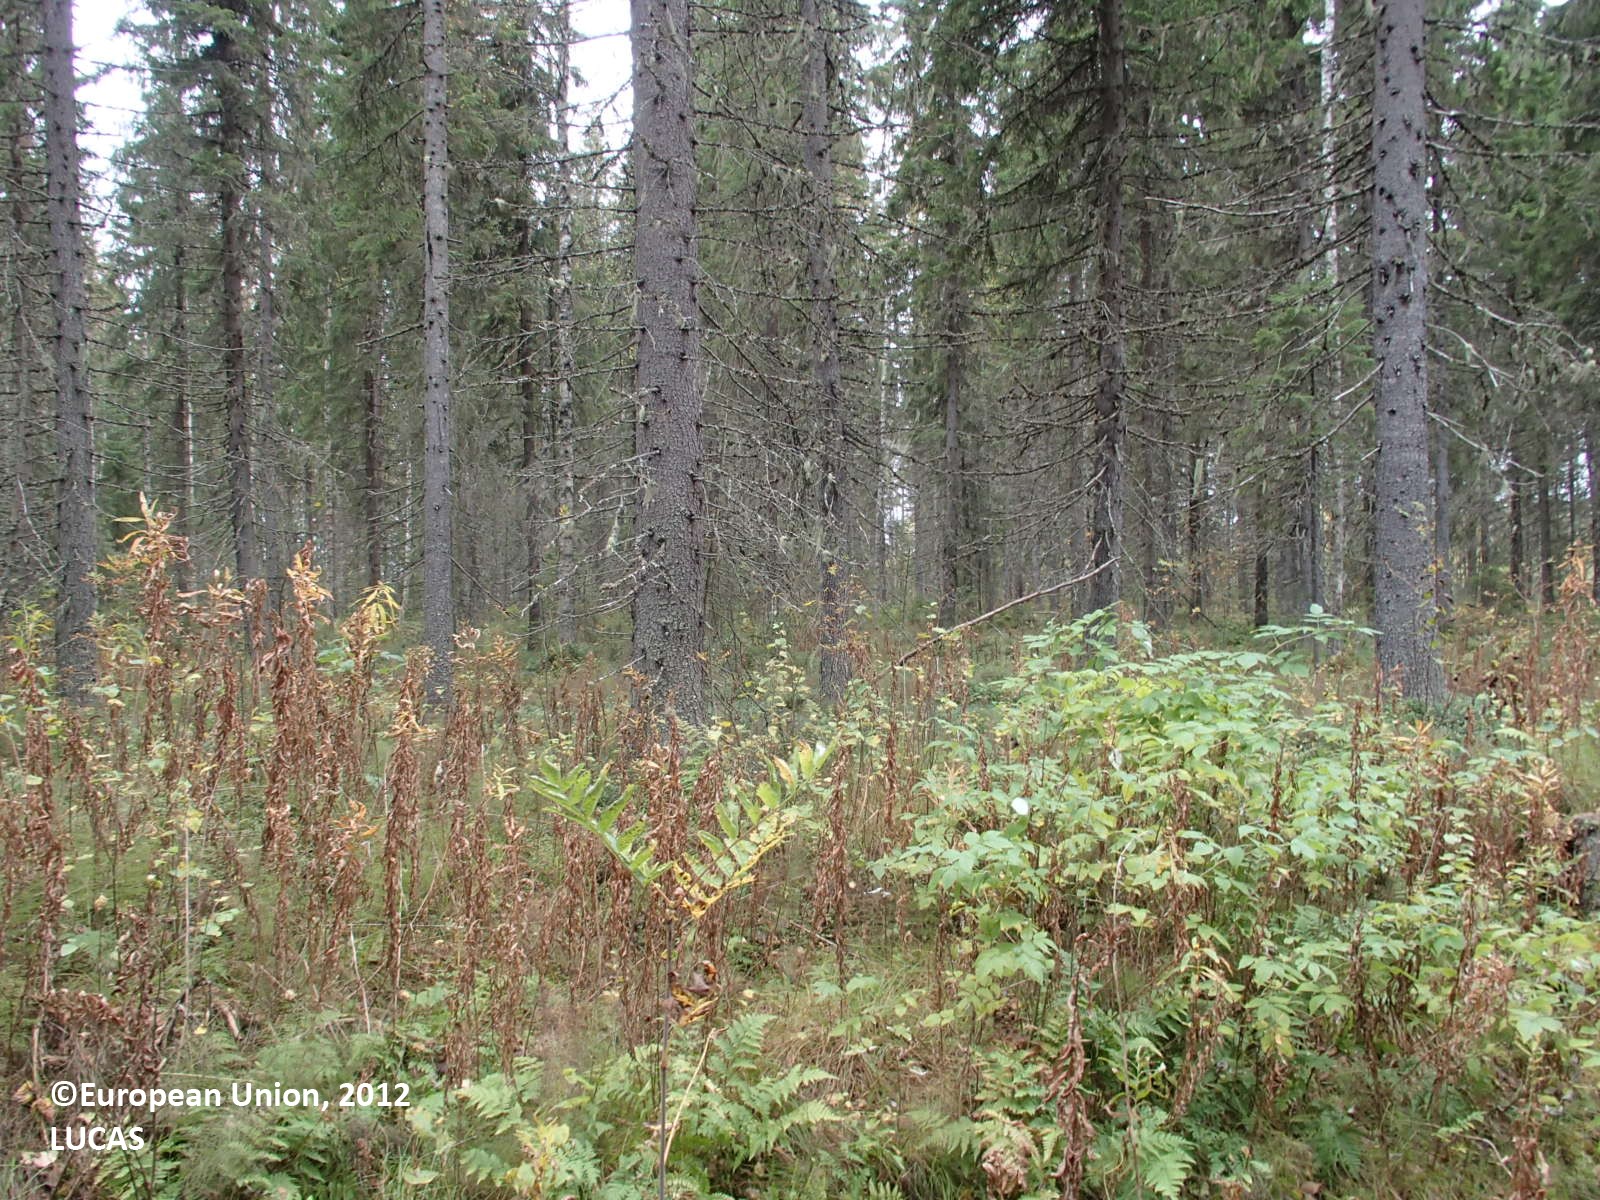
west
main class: Woodland
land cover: Spruce dominated coniferous woodland
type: boreal forest
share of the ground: 50 - 75 %
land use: Forestry
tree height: > 5 m
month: September
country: FI
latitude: 63.5387
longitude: 26.0247
